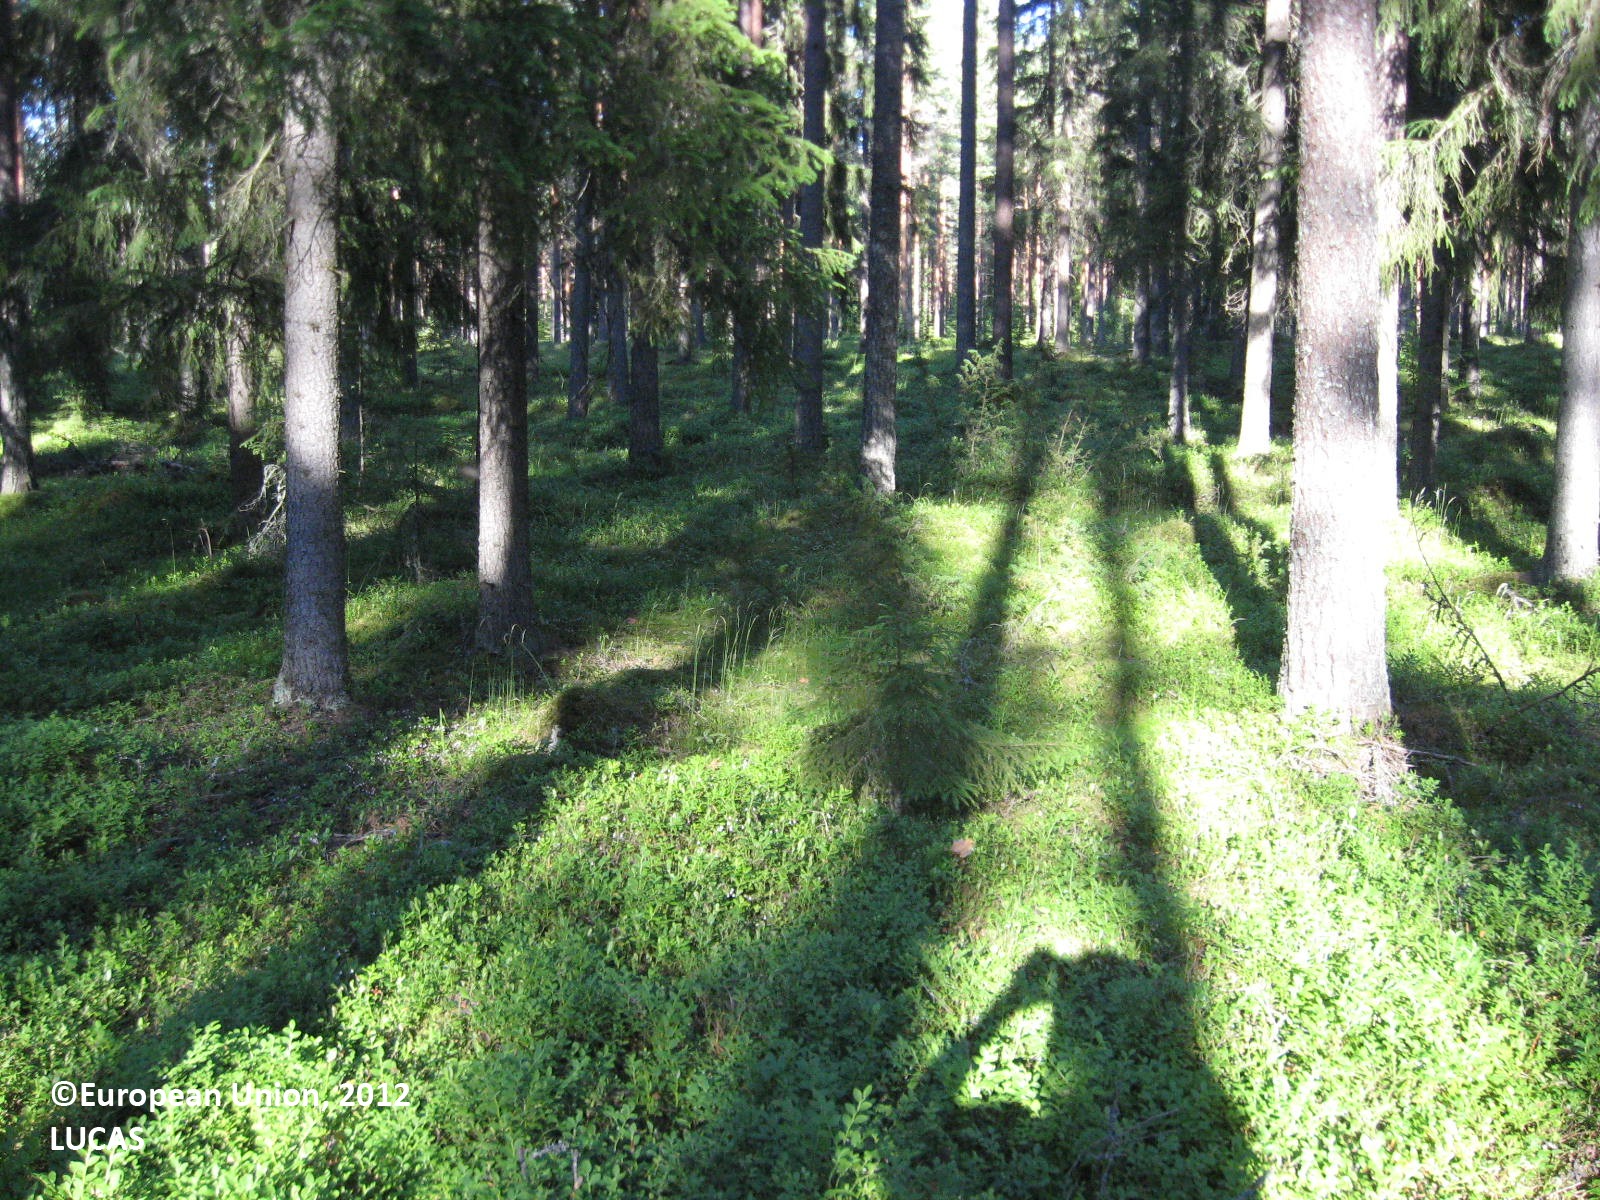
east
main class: Woodland
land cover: Other coniferous woodland
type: boreal forest
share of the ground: > 75 %
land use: Forestry
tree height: > 5 m
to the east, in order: Other coniferous woodland; Pine dominated coniferous woodland
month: July
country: FI
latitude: 62.7476
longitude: 22.7218
